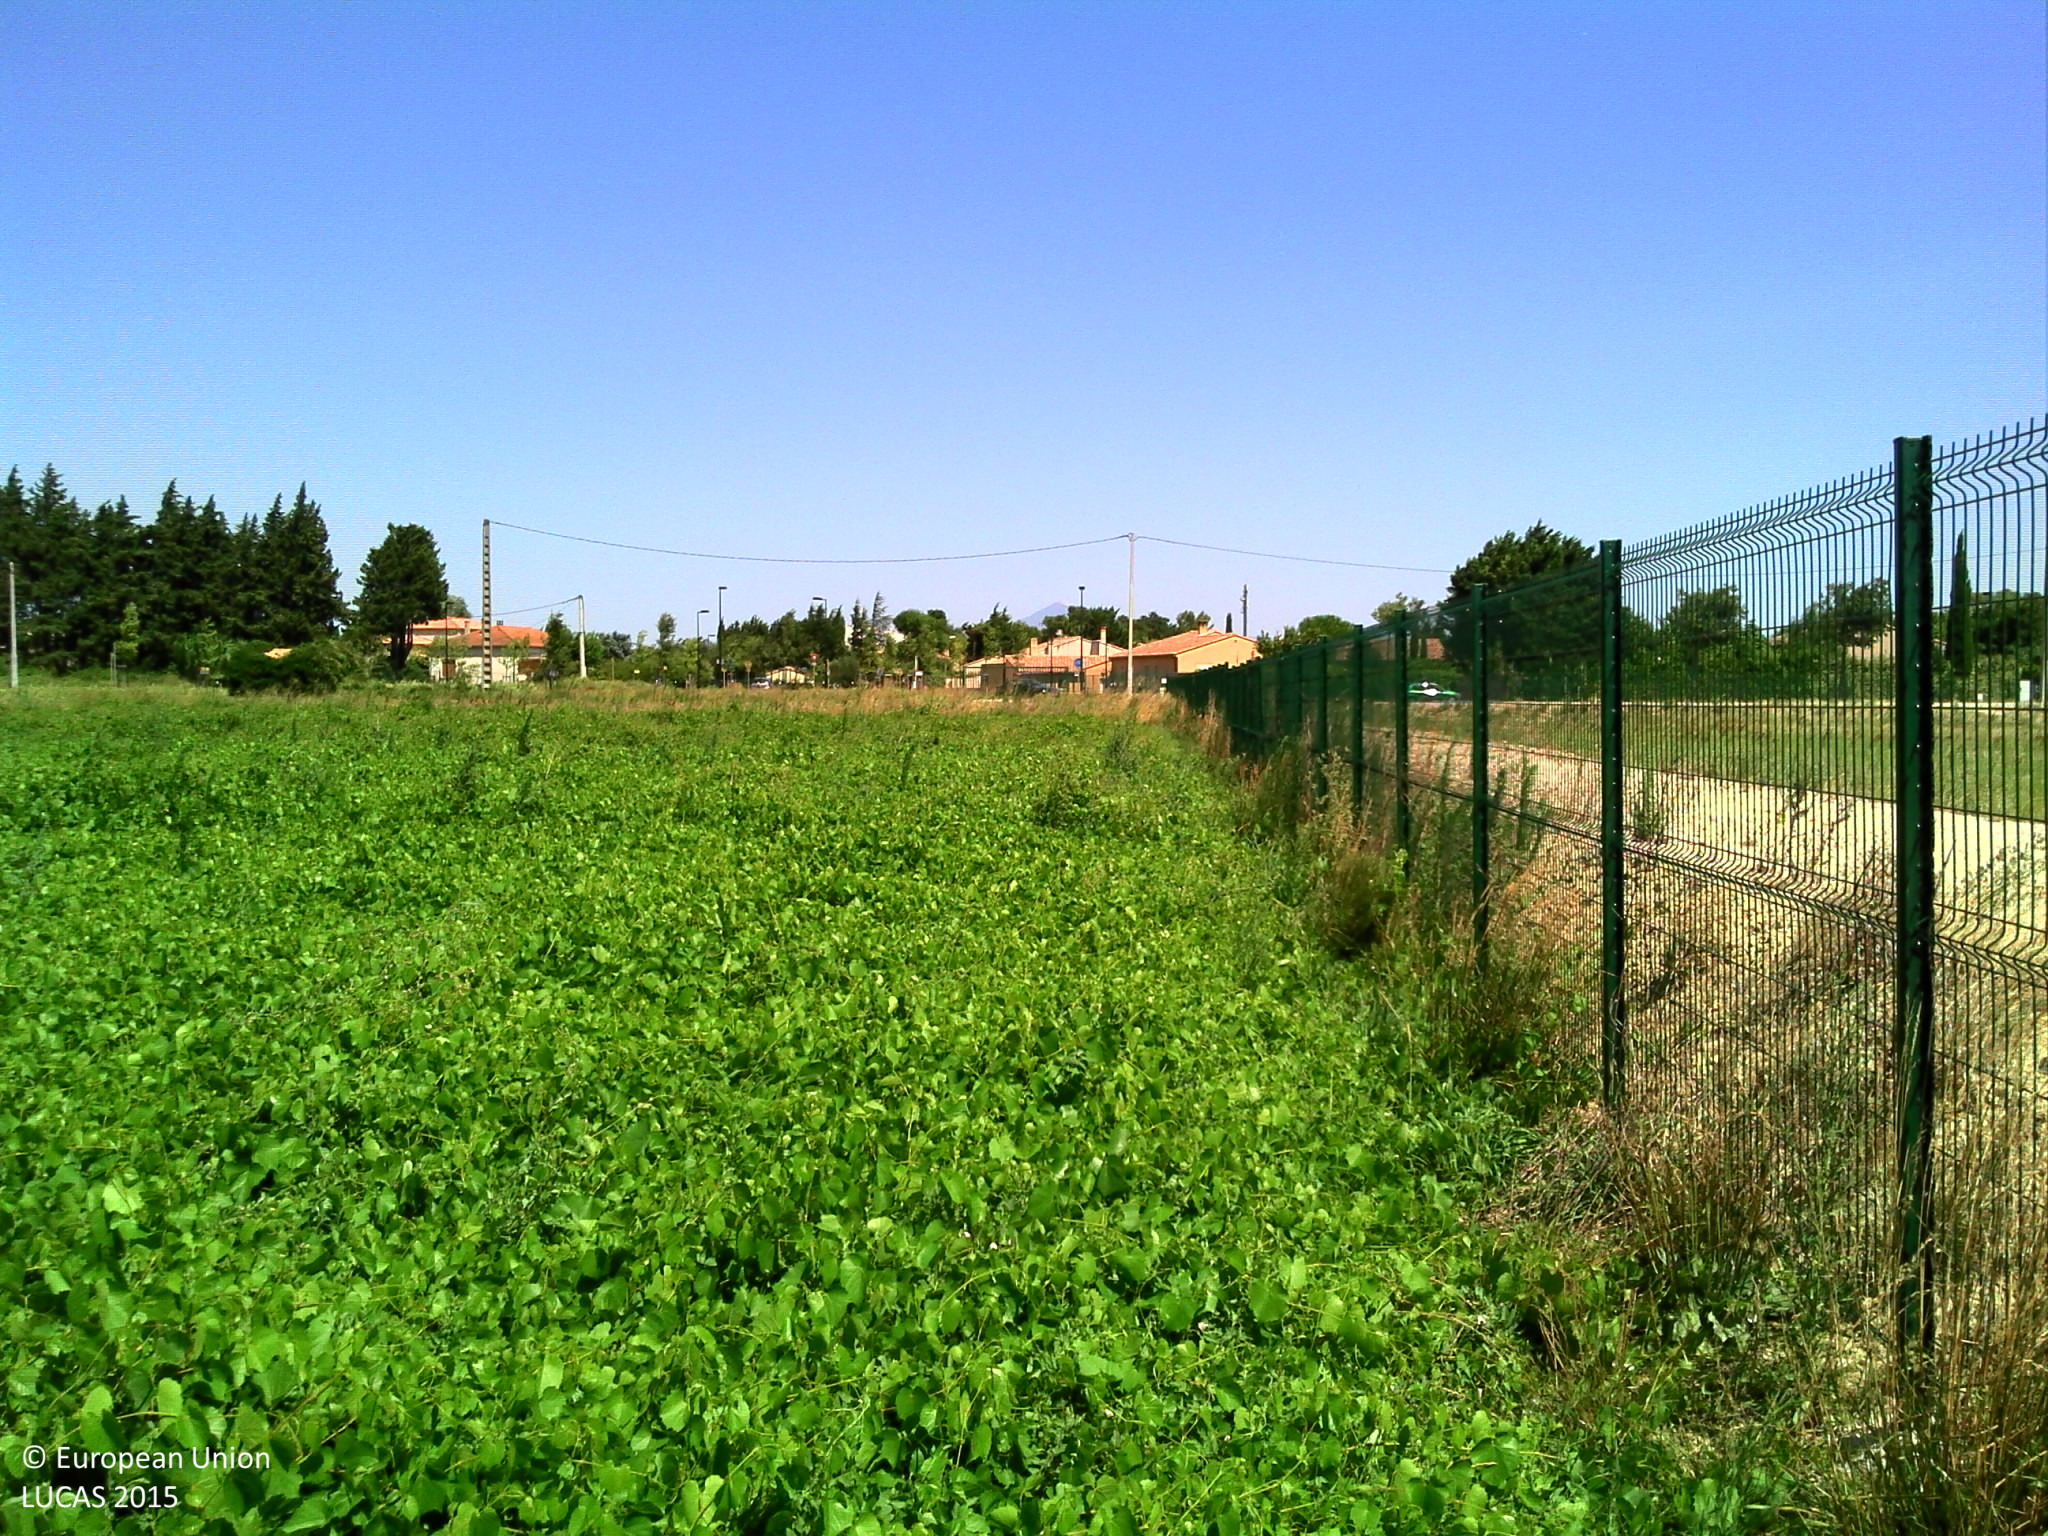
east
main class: Cropland
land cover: Nurseries
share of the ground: > 75 %
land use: Agriculture (excluding fallow land and kitchen gardens)
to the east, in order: Nurseries; Artificial constructions in urban areas
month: July
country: FR
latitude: 44.1476
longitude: 4.7946
